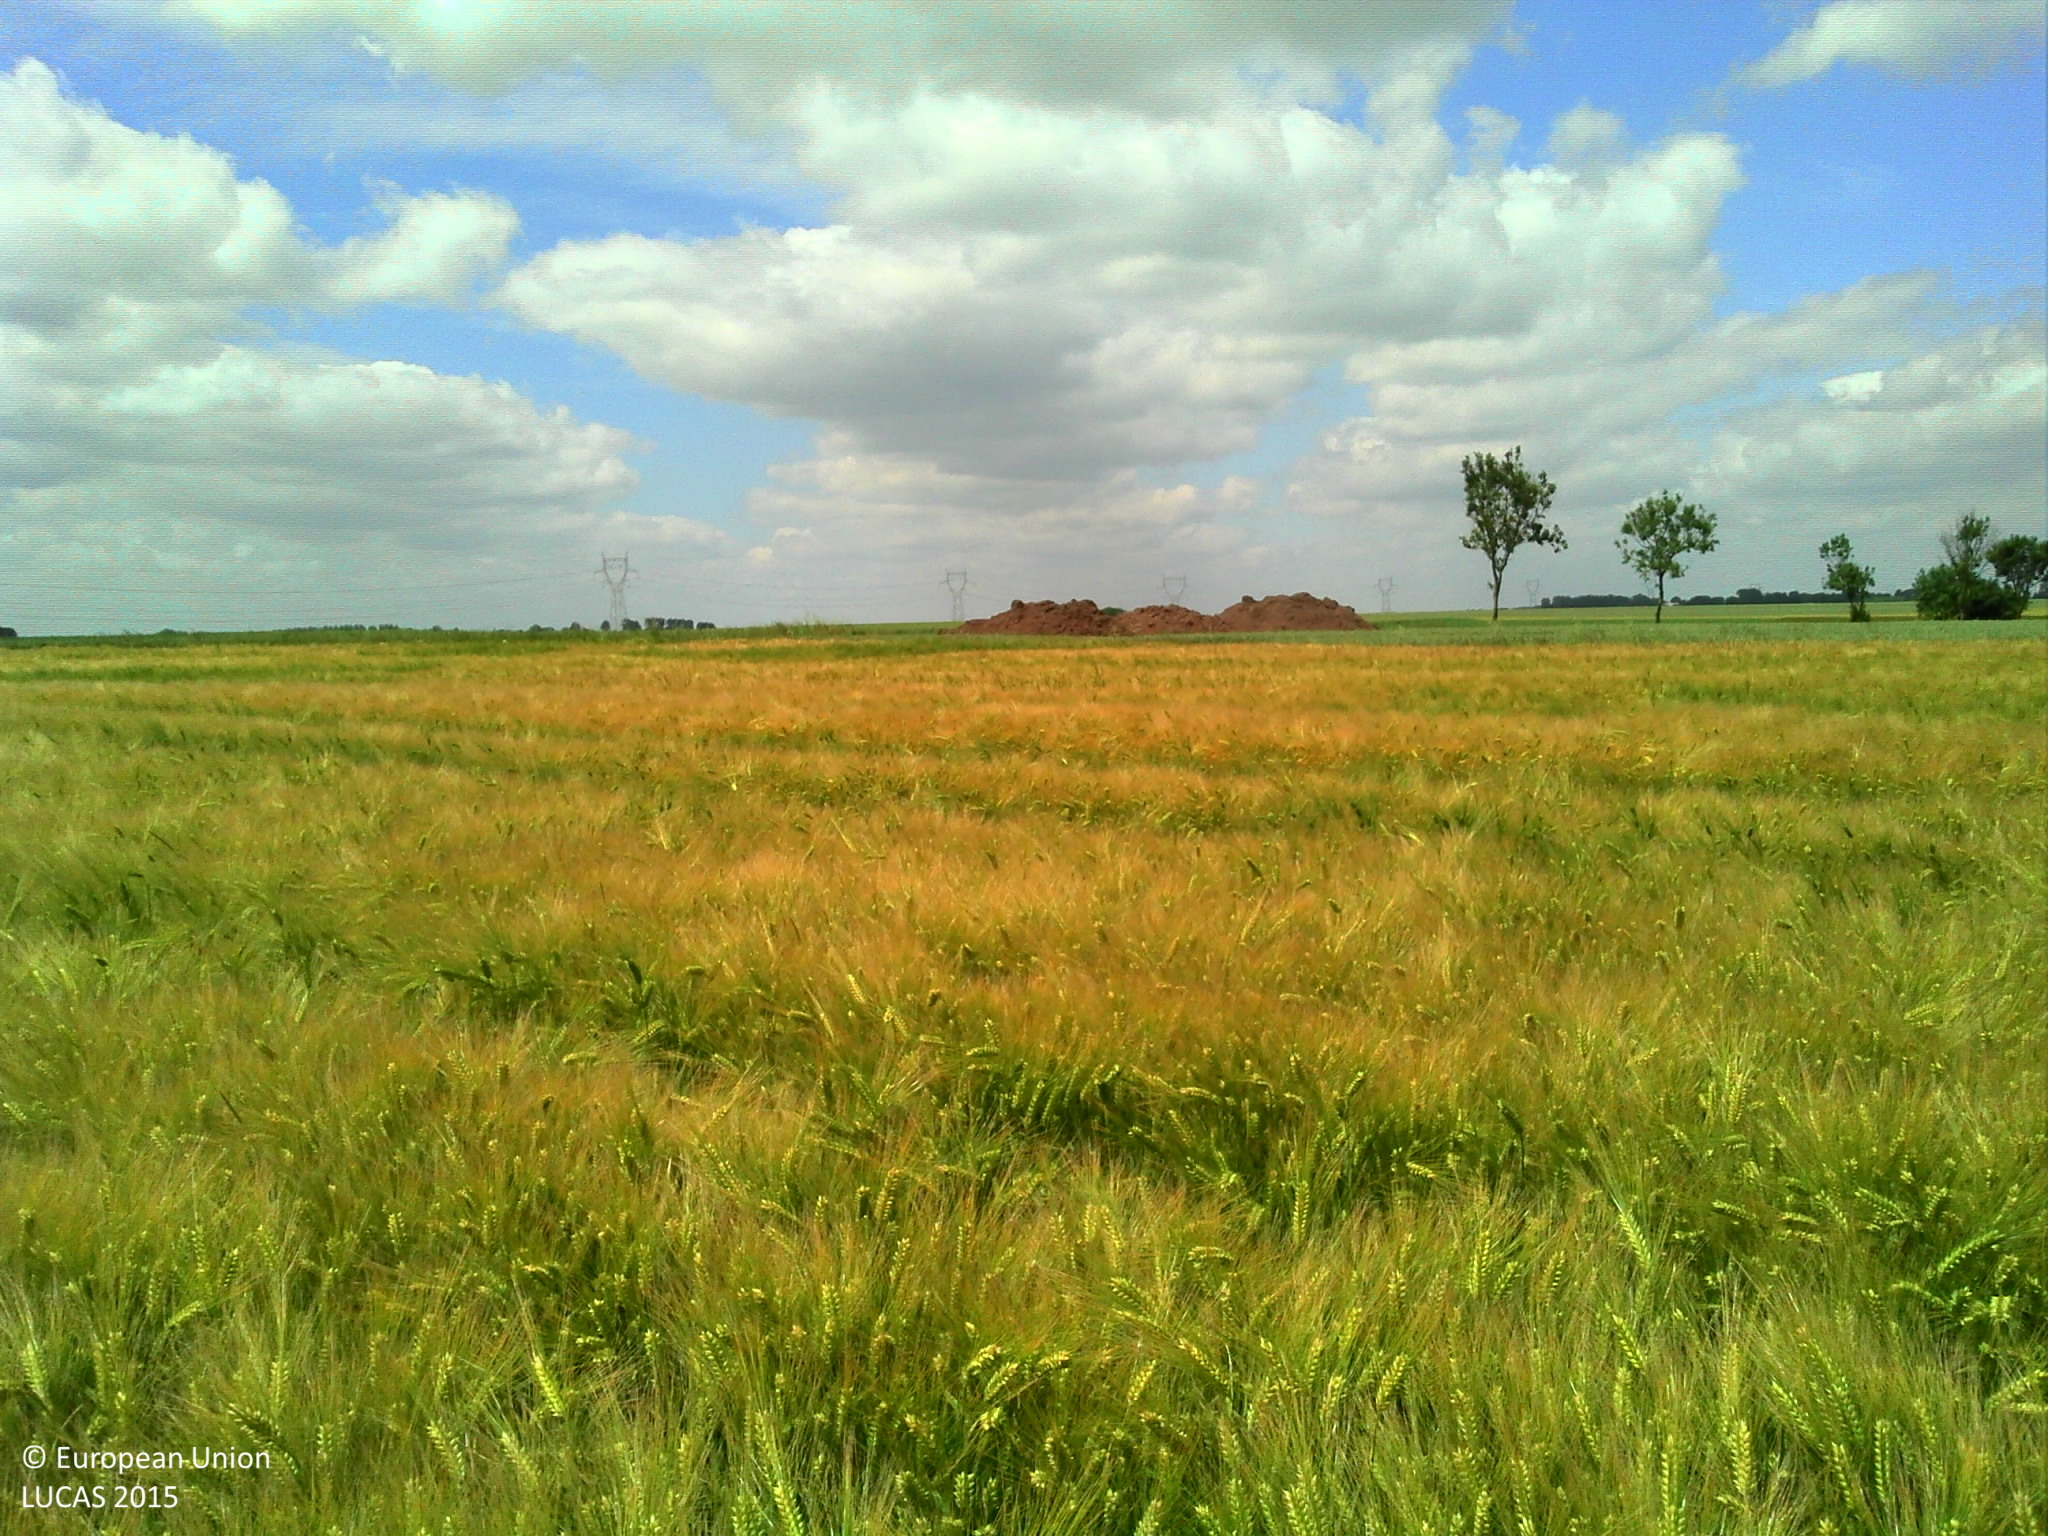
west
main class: Cropland
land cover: Barley
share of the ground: > 75 %
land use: Agriculture (excluding fallow land and kitchen gardens)
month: June
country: FR
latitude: 50.3861
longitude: 2.4627
